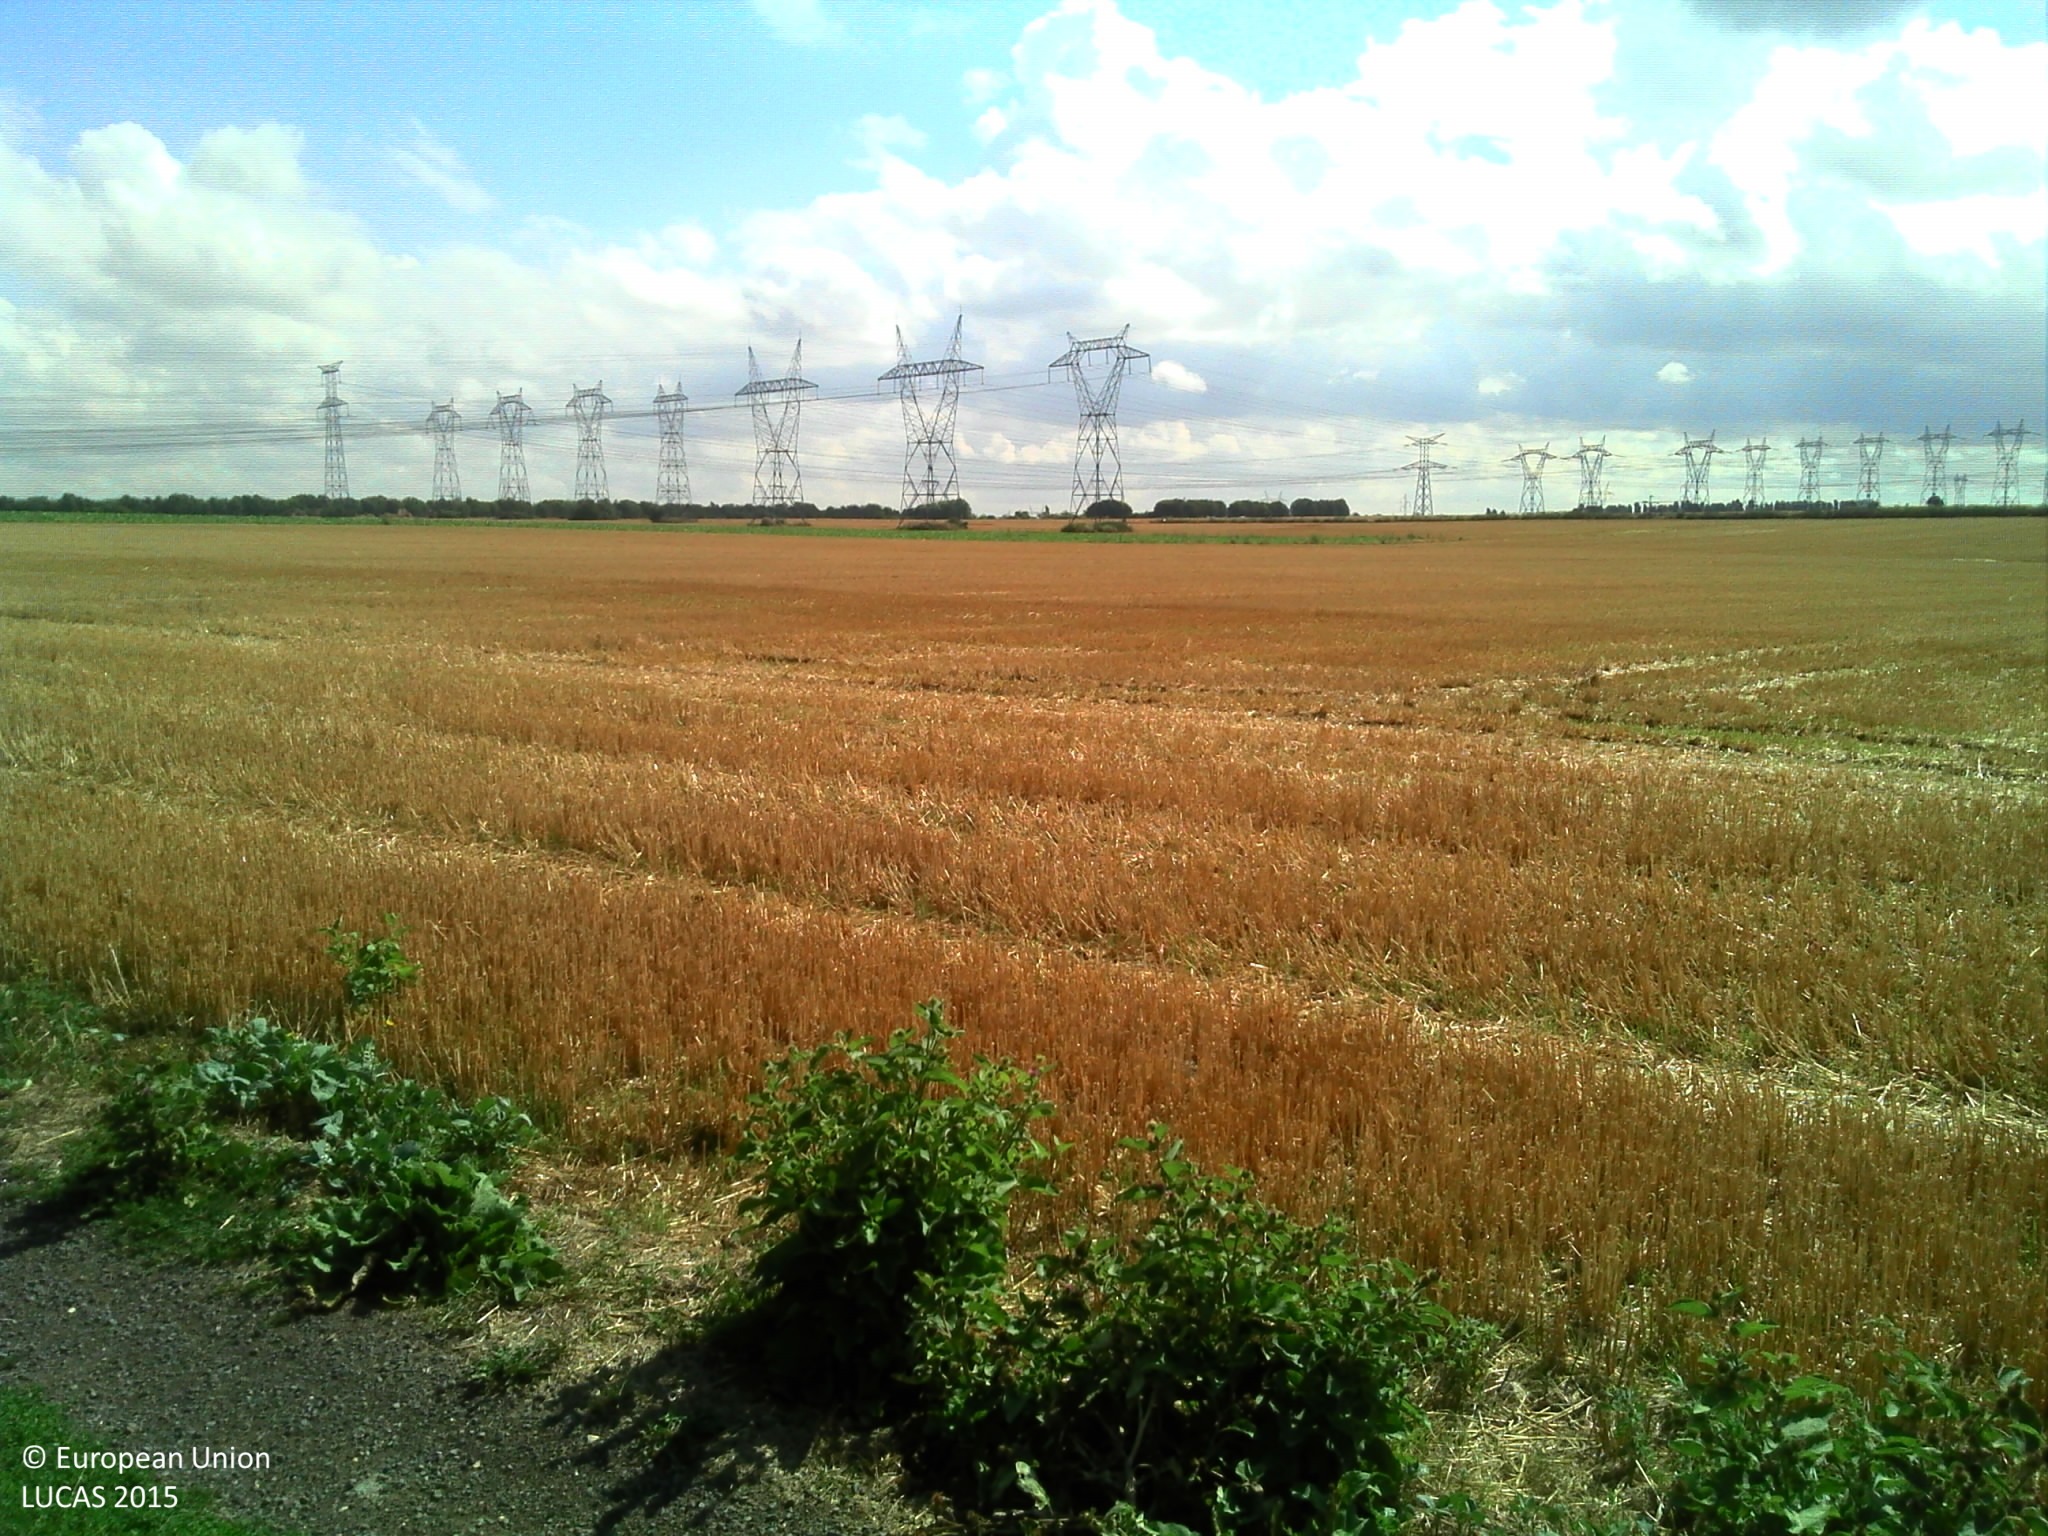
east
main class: Cropland
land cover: Maize
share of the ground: > 75 %
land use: Agriculture (excluding fallow land and kitchen gardens)
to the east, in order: Maize
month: August
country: FR
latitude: 49.0467
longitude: 2.4221
